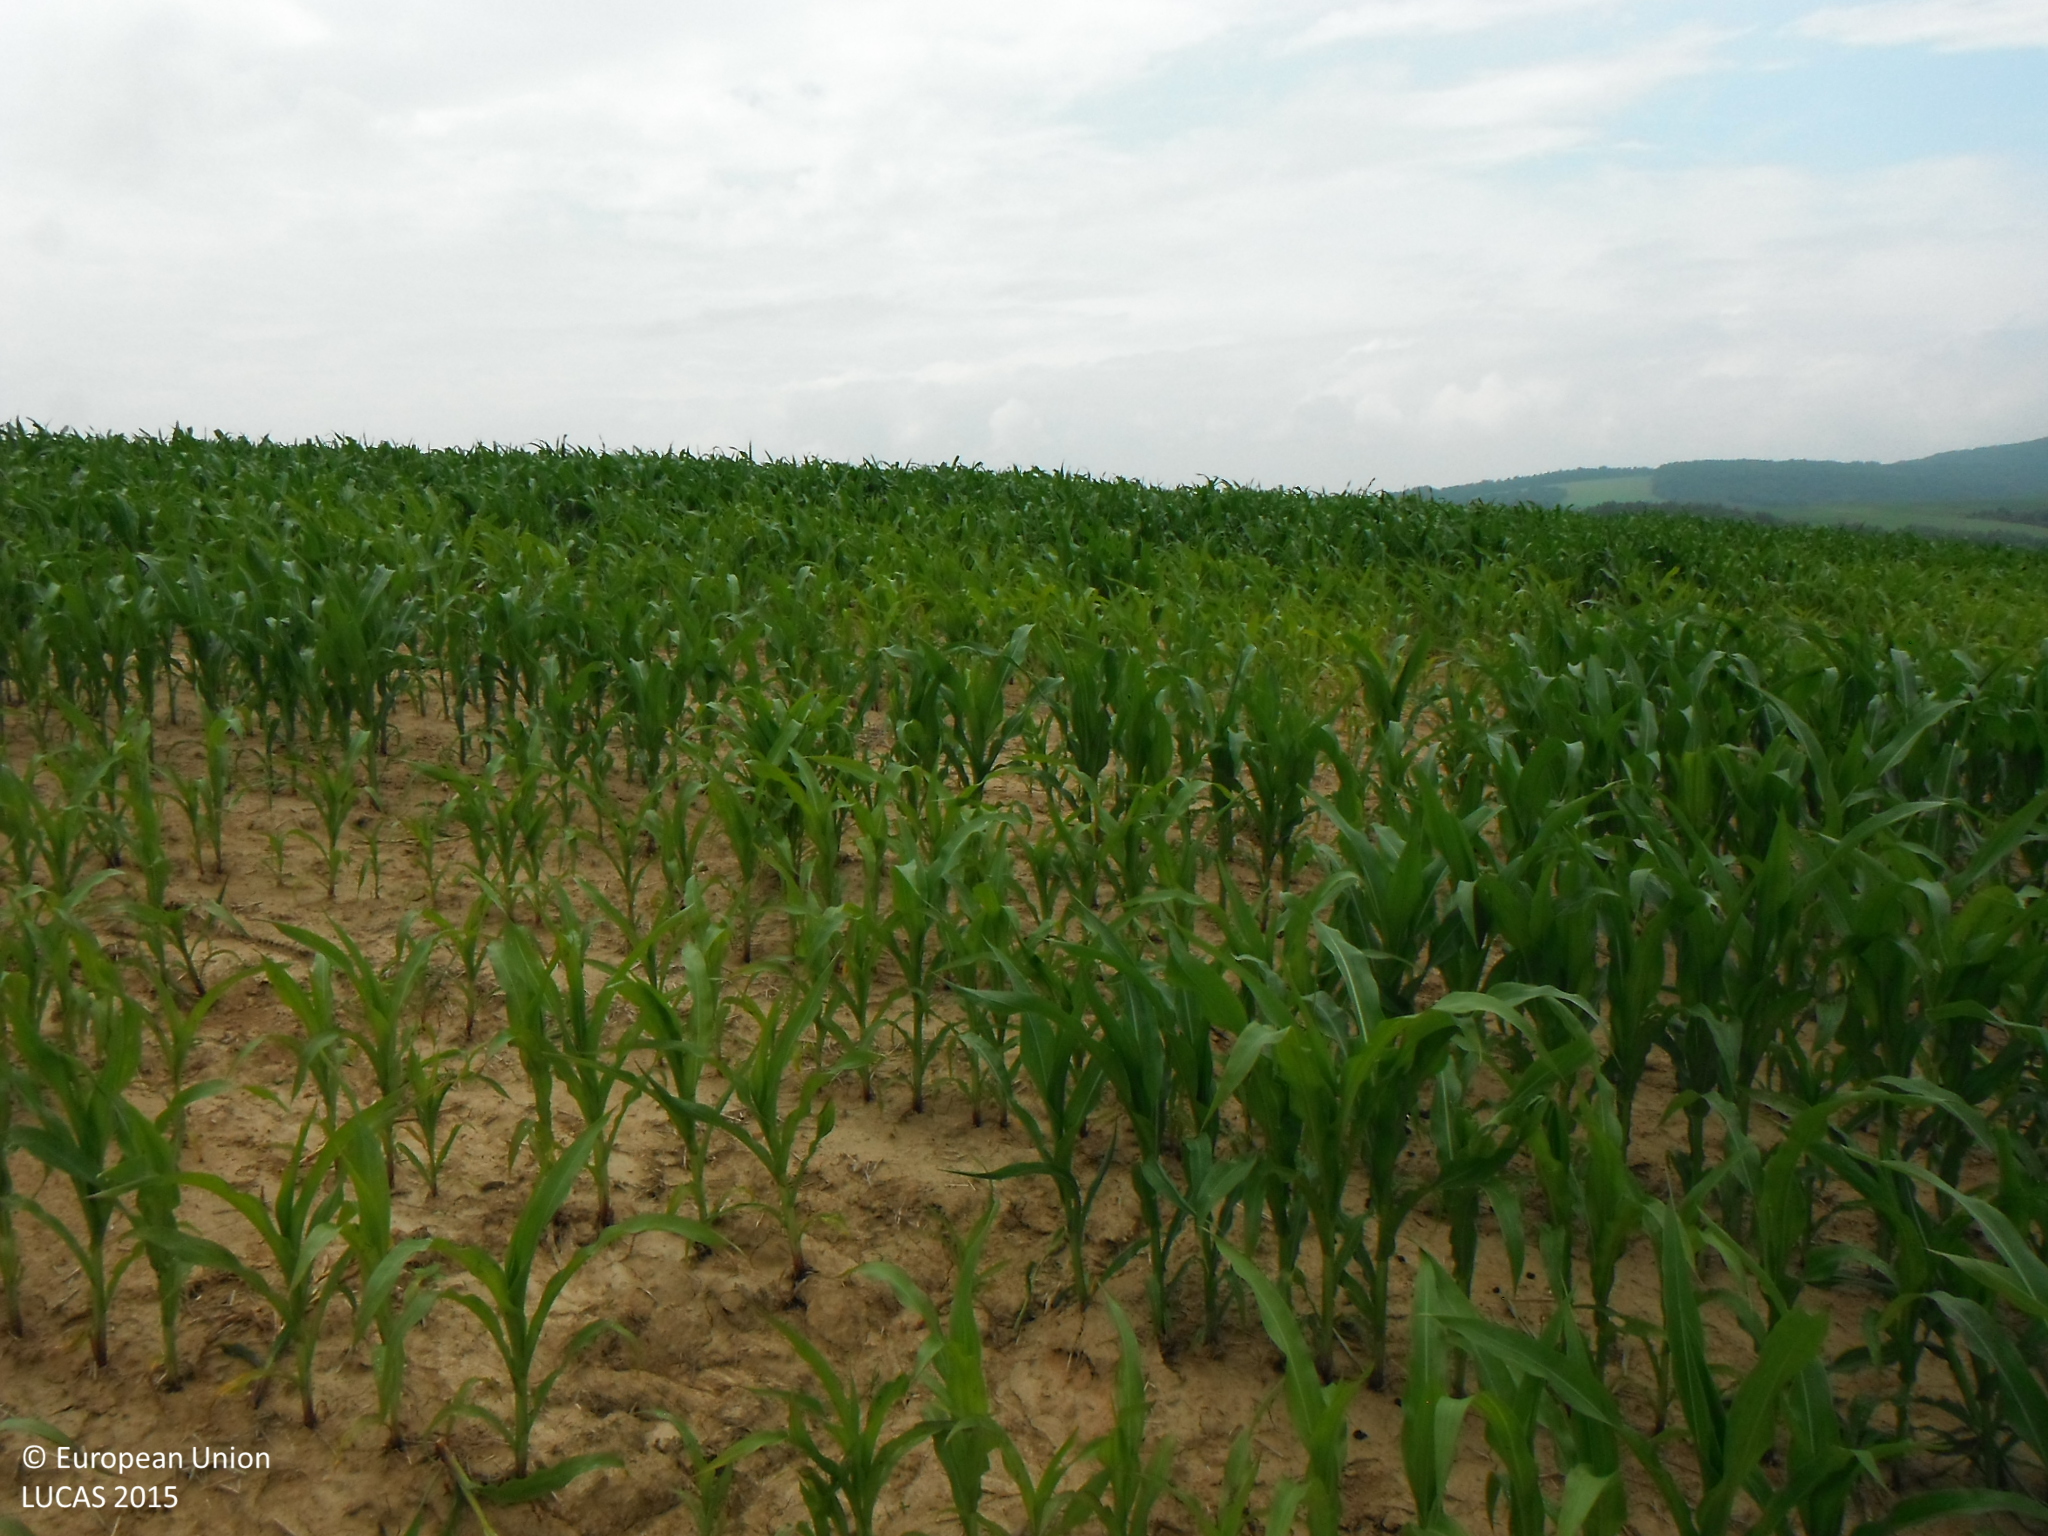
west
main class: Cropland
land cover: Maize
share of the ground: 25 - 50 %
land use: Agriculture (excluding fallow land and kitchen gardens)
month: June
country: SK
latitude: 49.2358
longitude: 21.6842
